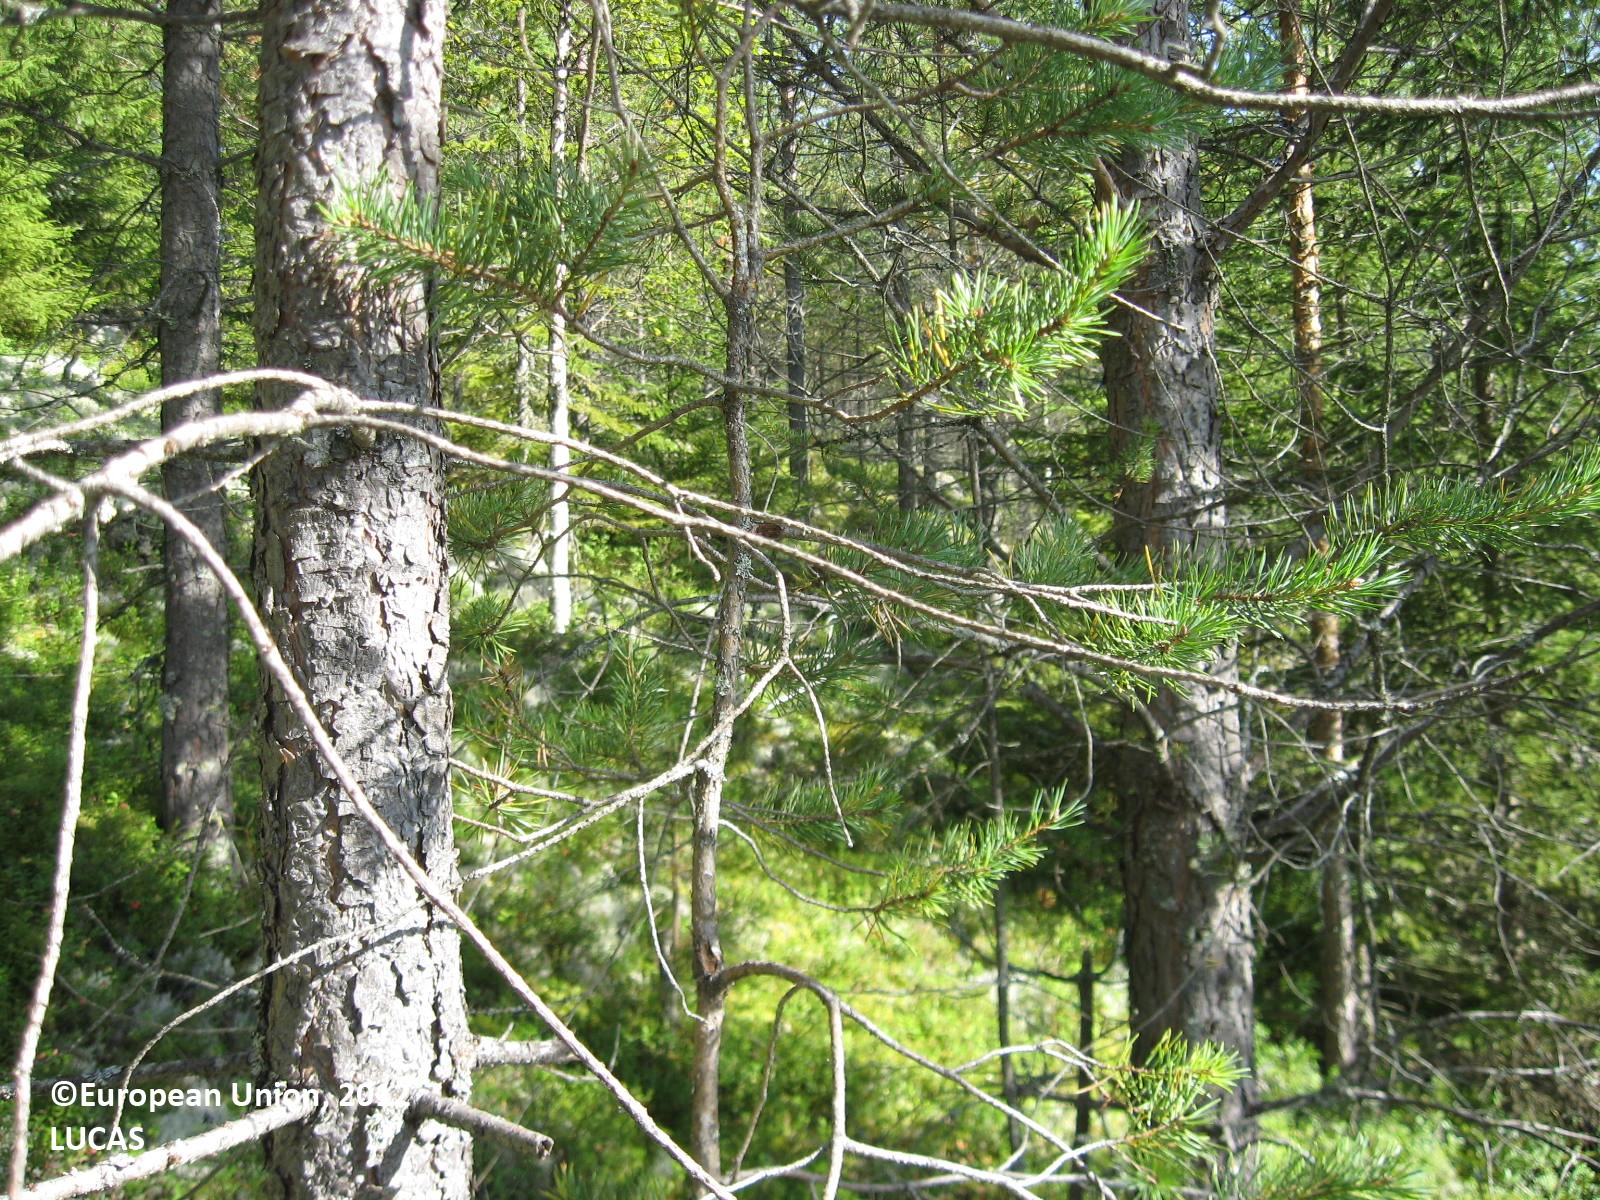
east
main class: Woodland
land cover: Pine dominated coniferous woodland
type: boreal forest
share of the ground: > 75 %
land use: Forestry
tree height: > 5 m
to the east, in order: Pine dominated coniferous woodland; Ditches and canals; Grass margins; Paved roads, cycling and walking lanes; Grass margins; Ditches and canals; Pine dominated coniferous woodland; Ditches and canals; Pine dominated mixed woodland; Ditches and canals; Pine dominated mixed woodland
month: August
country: FI
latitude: 63.6798
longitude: 29.7420
